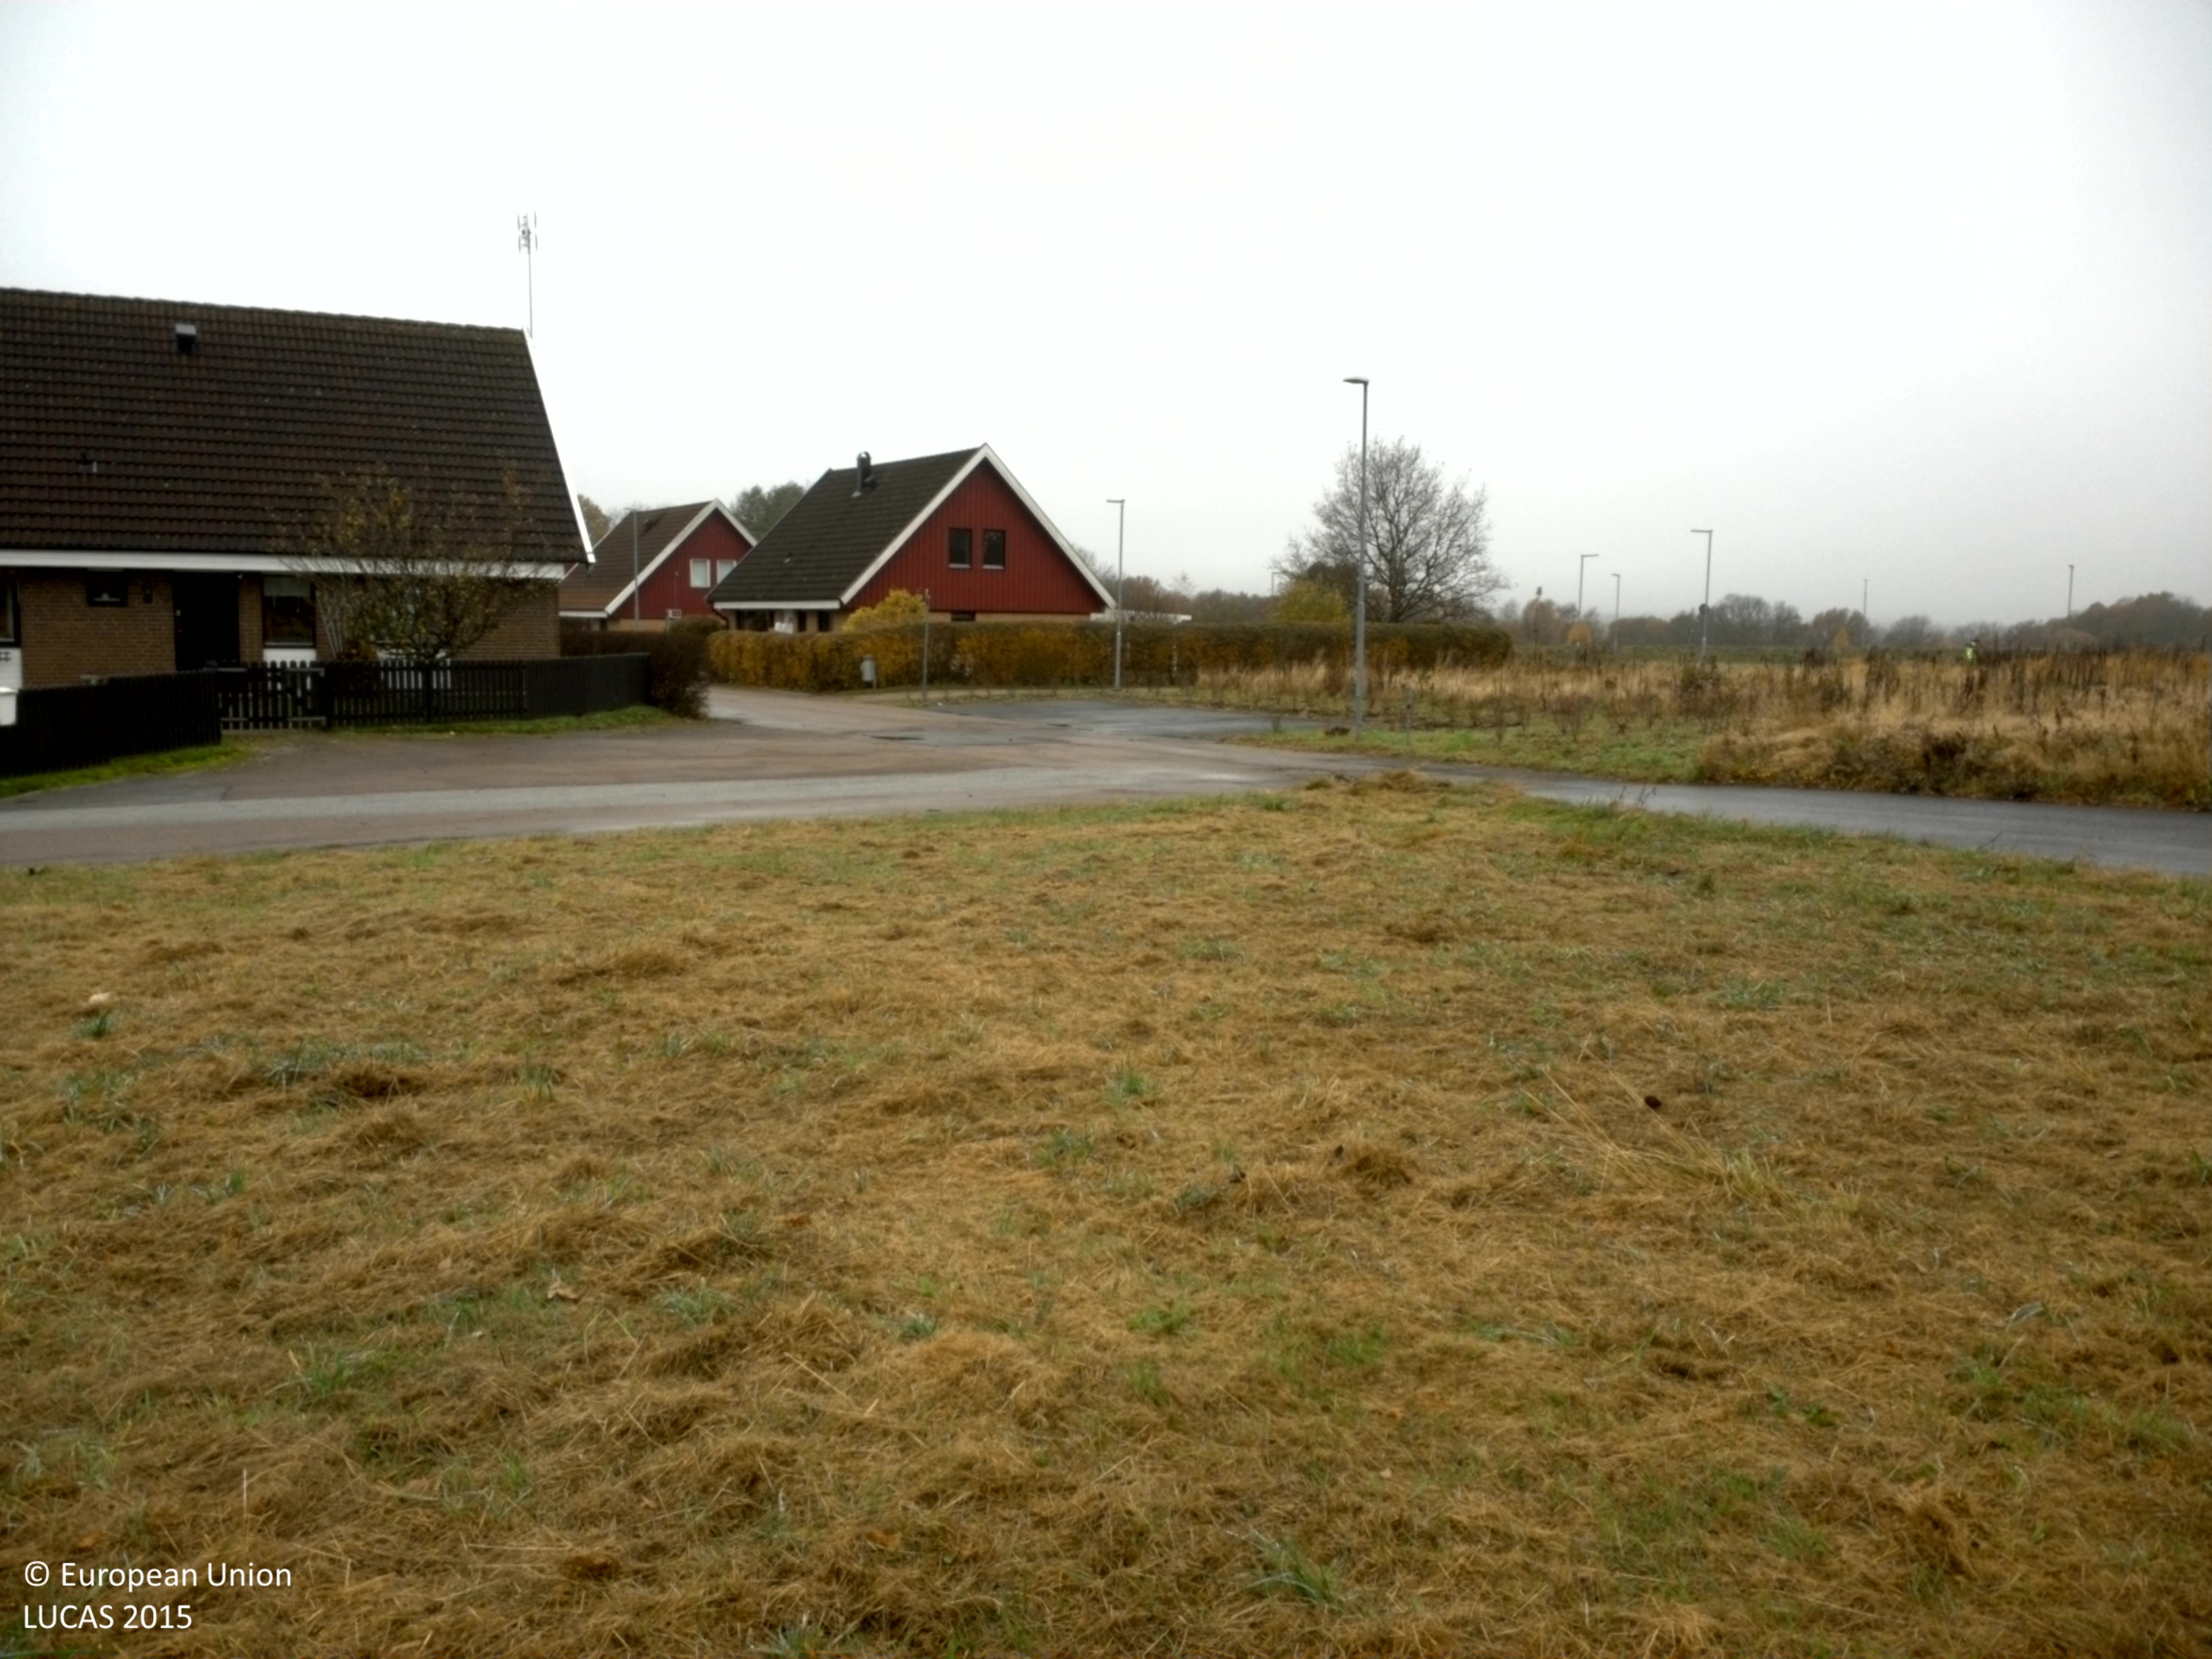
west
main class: Grassland
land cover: Grassland without tree/shrub cover
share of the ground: > 75 %
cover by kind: herbaceous plants 100 %
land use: Residential
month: November
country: SE
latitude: 56.0066
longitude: 13.0928
